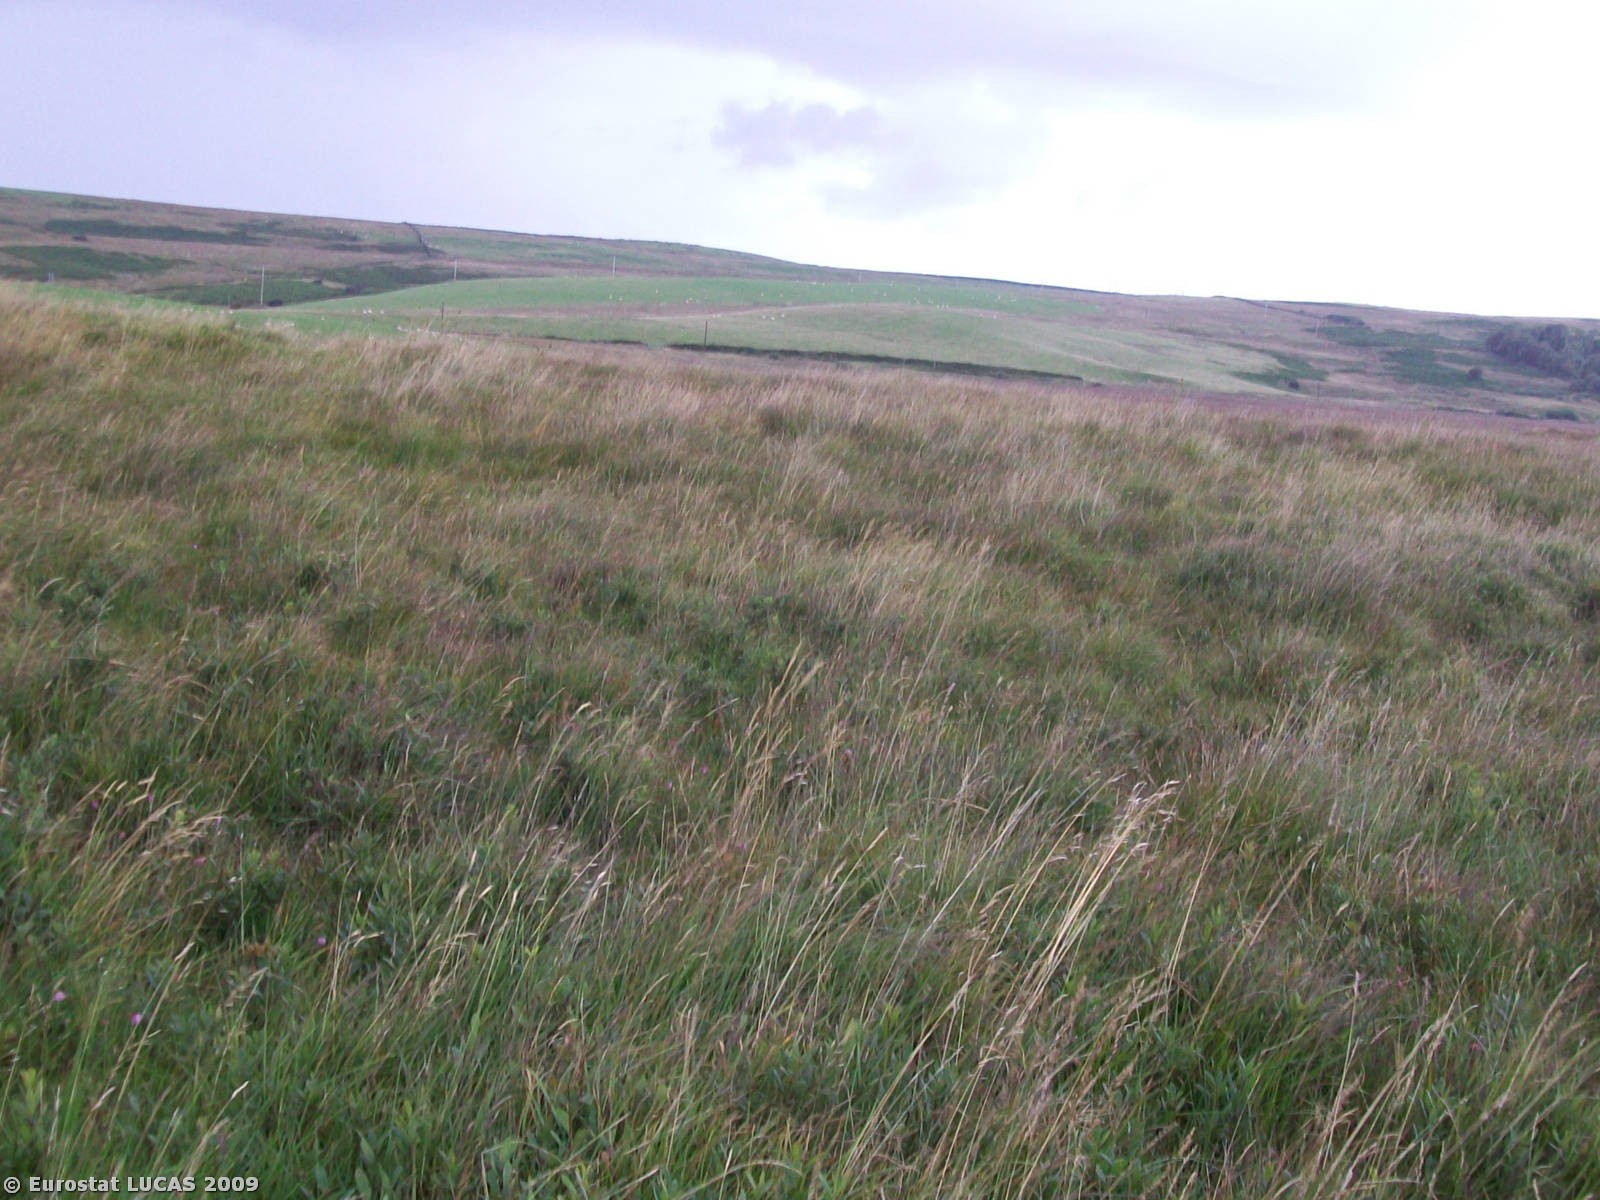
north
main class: Grassland
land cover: Grassland without tree/shrub cover
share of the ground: > 75 %
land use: Agriculture (excluding fallow land and kitchen gardens)
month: August
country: GB
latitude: 54.9070
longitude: -4.7533
